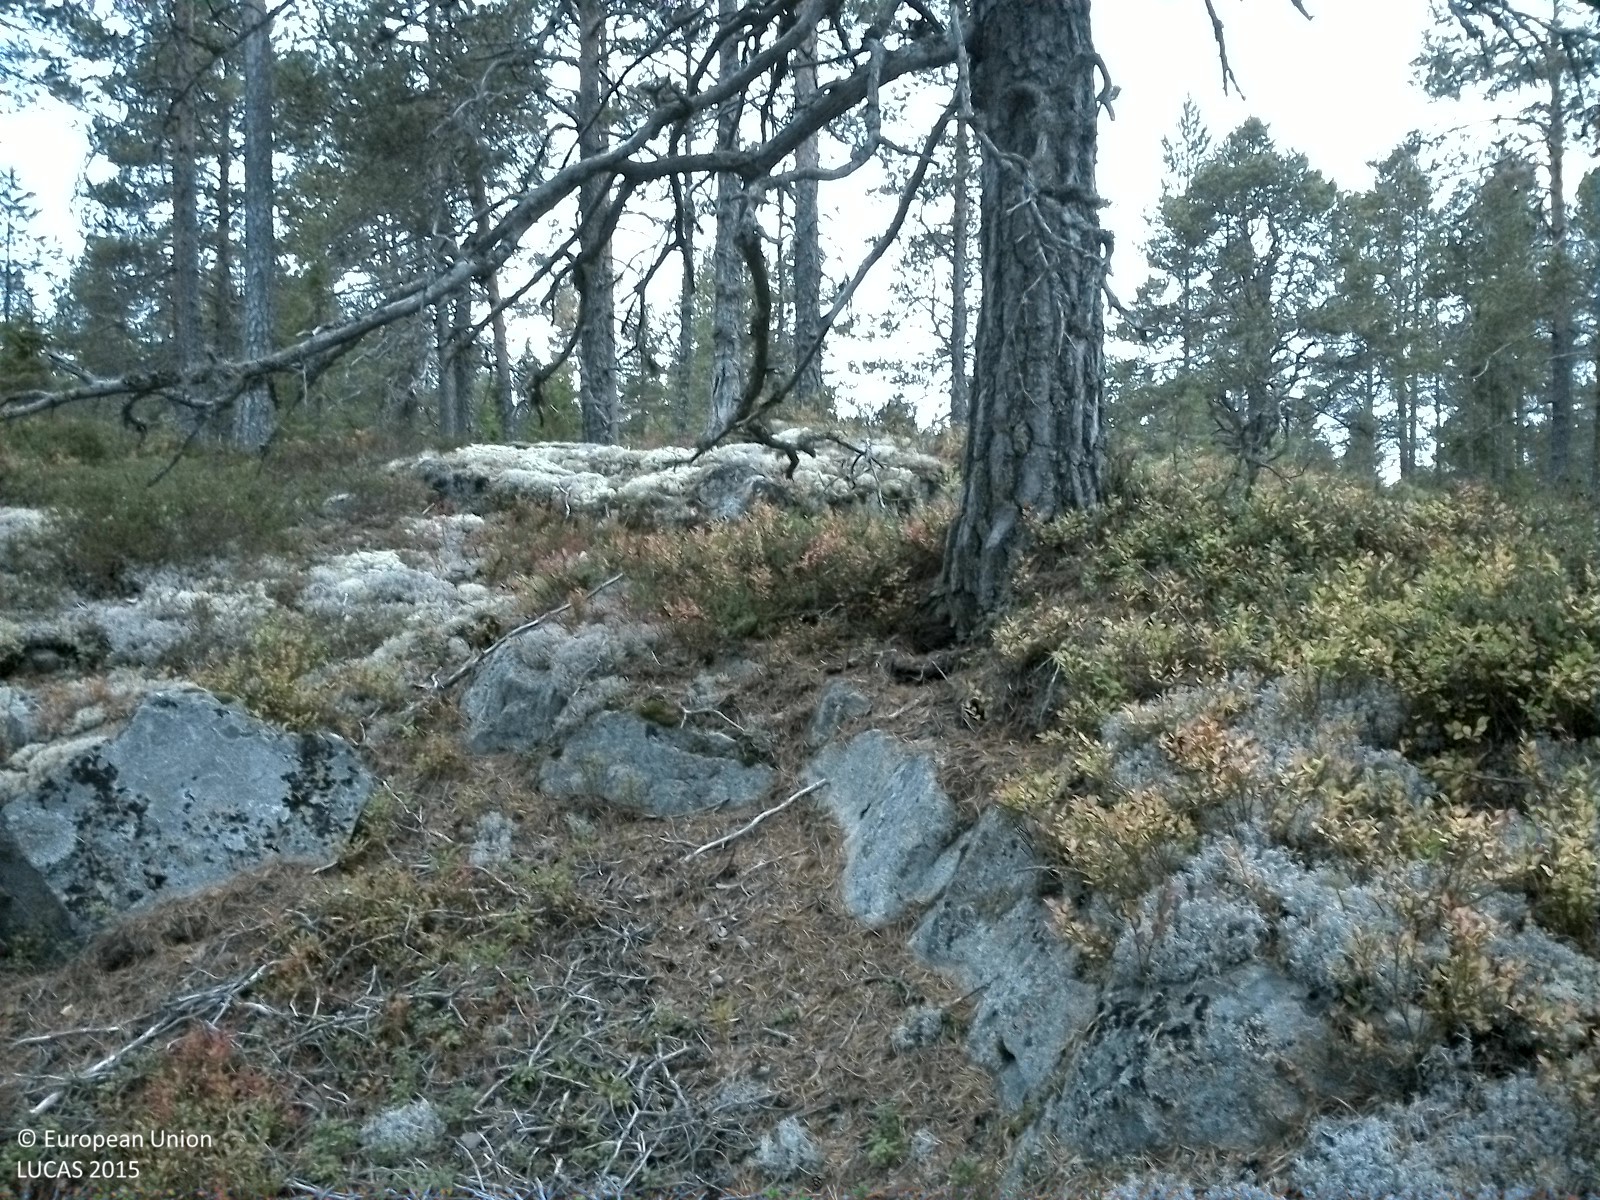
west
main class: Woodland
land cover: Pine dominated coniferous woodland
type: boreal forest
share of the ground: 25 - 50 %
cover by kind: lichens and mosses 40 %, shrubs 30 %, coniferous forest trees 25 %
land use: Forestry
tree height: > 5 m
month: October
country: SE
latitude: 62.5621
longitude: 17.6640
